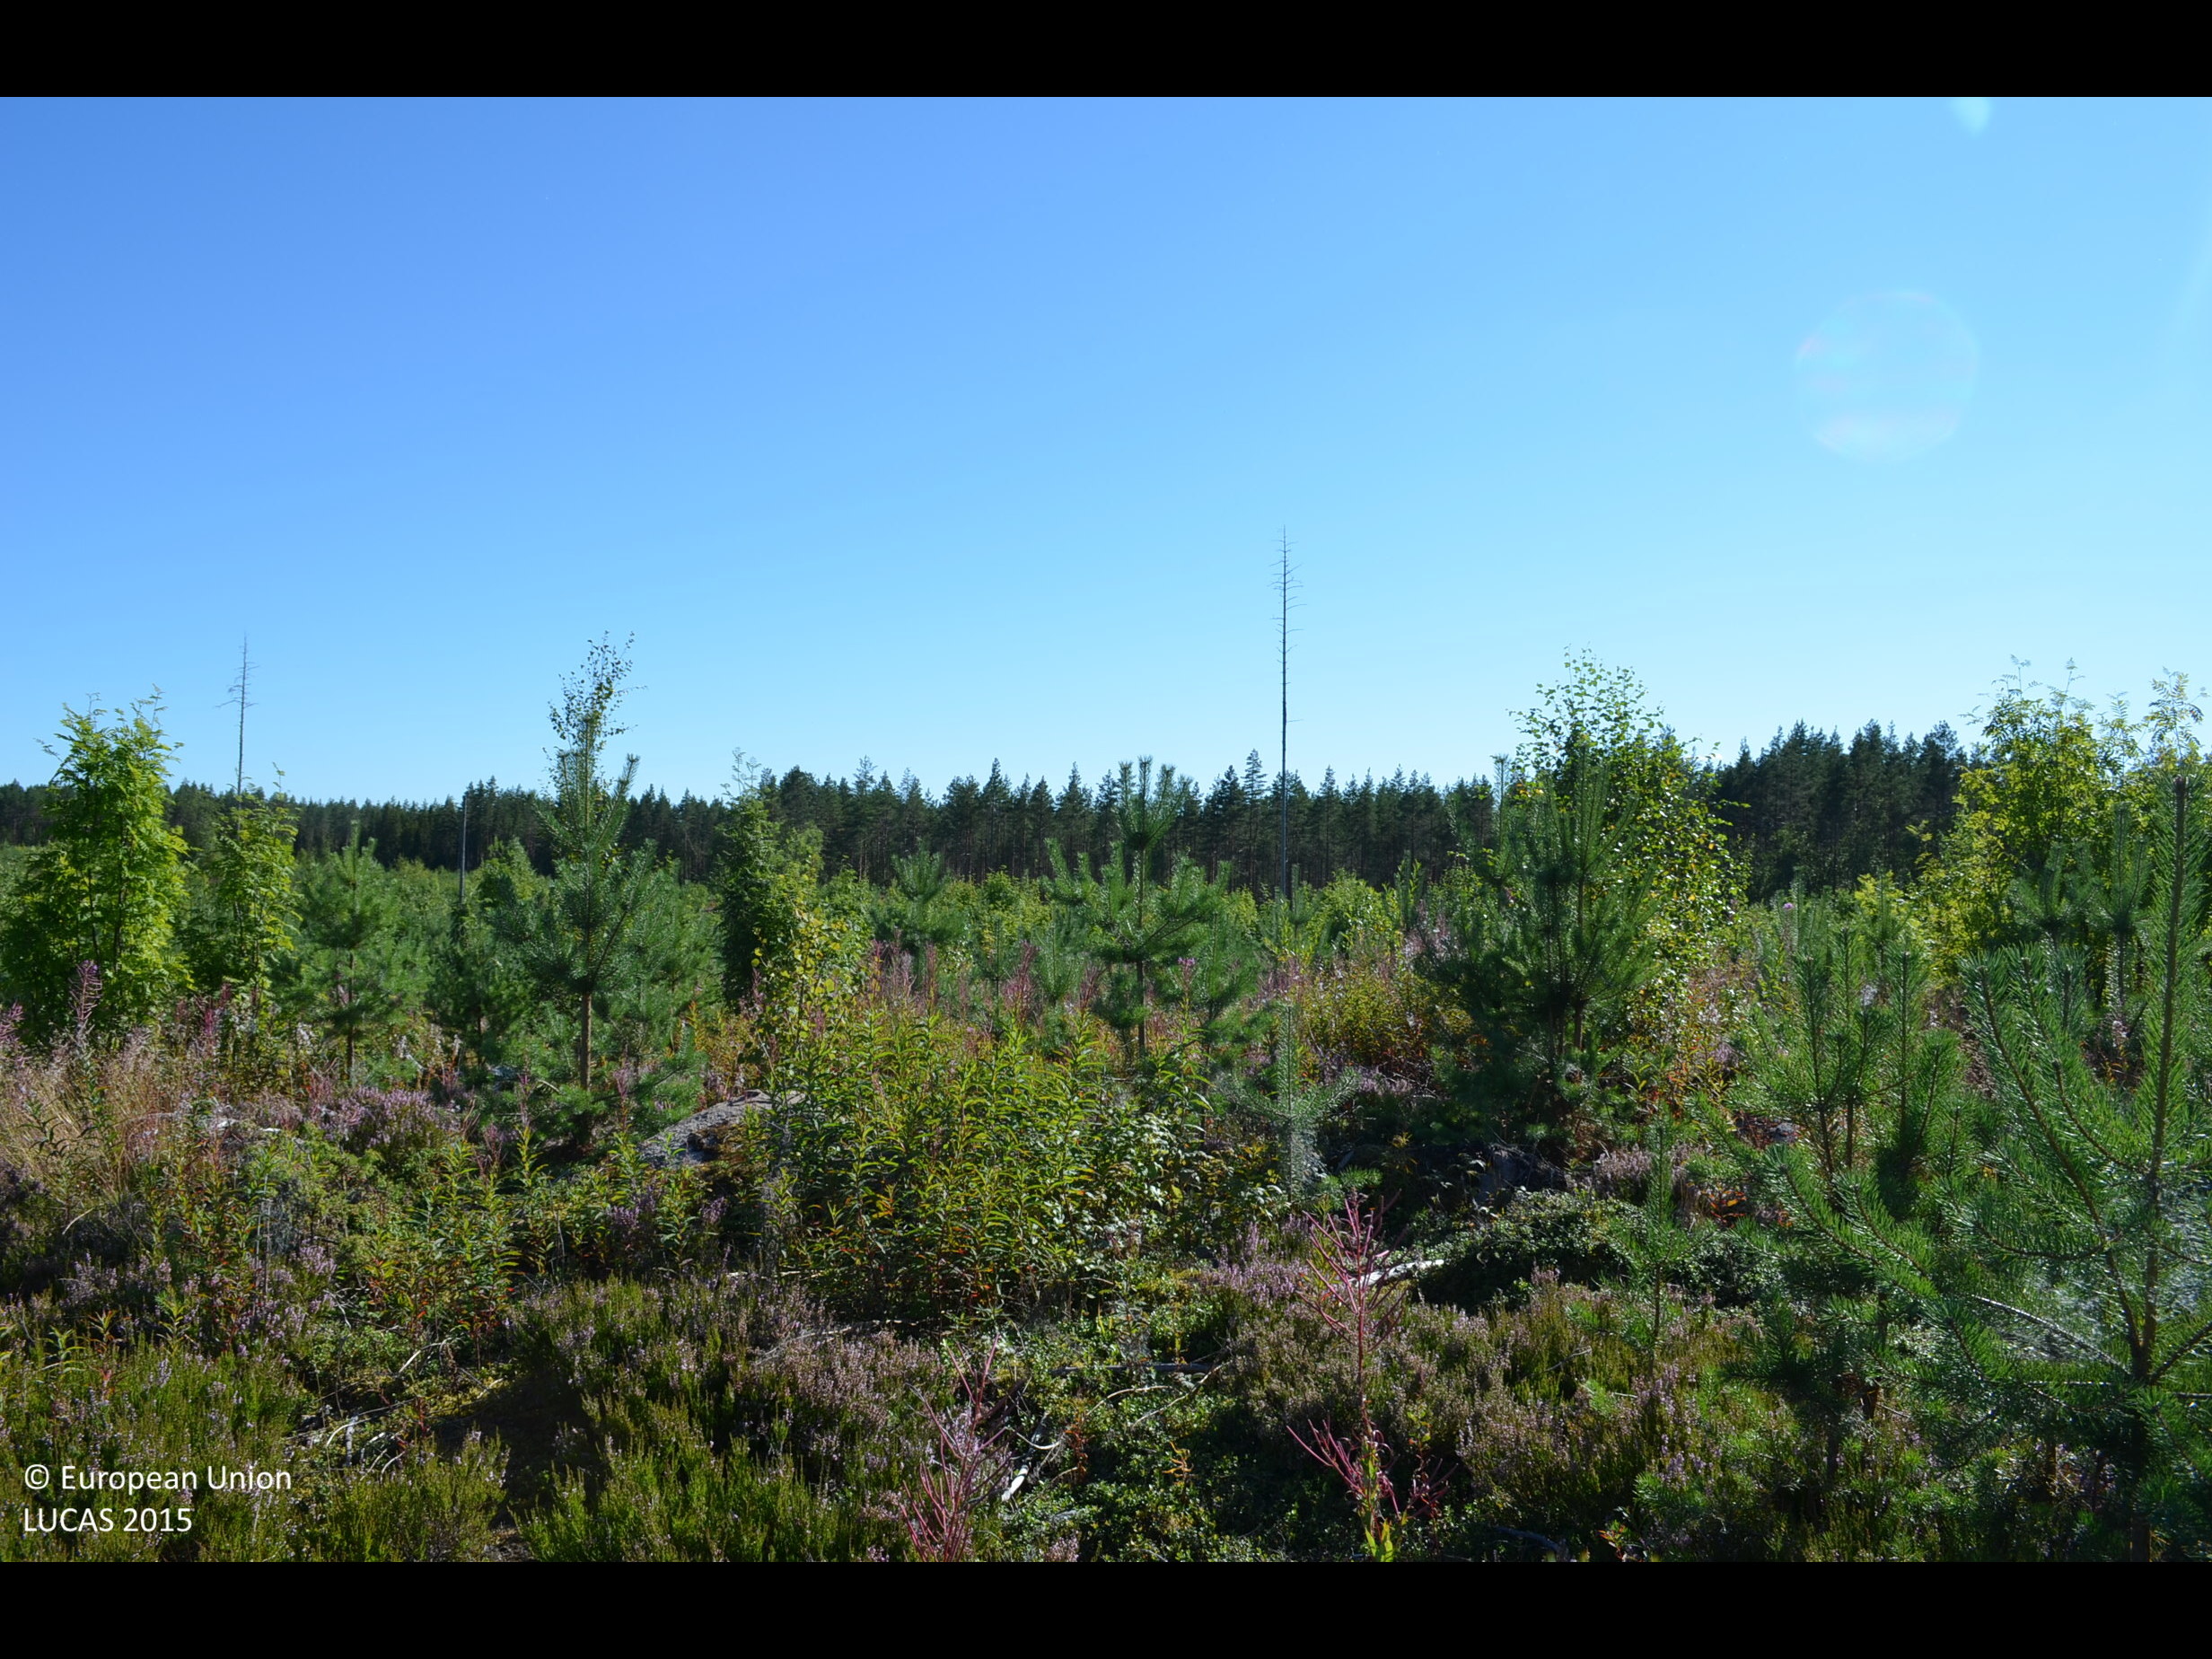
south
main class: Woodland
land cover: Pine dominated mixed woodland
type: boreal forest
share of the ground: 25 - 50 %
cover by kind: coniferous forest trees 30 %, shrubs 30 %, herbaceous plants 25 %, broadleaved forest trees 15 %
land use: Forestry
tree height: < 5 m
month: August
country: FI
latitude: 62.3881
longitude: 24.2623
